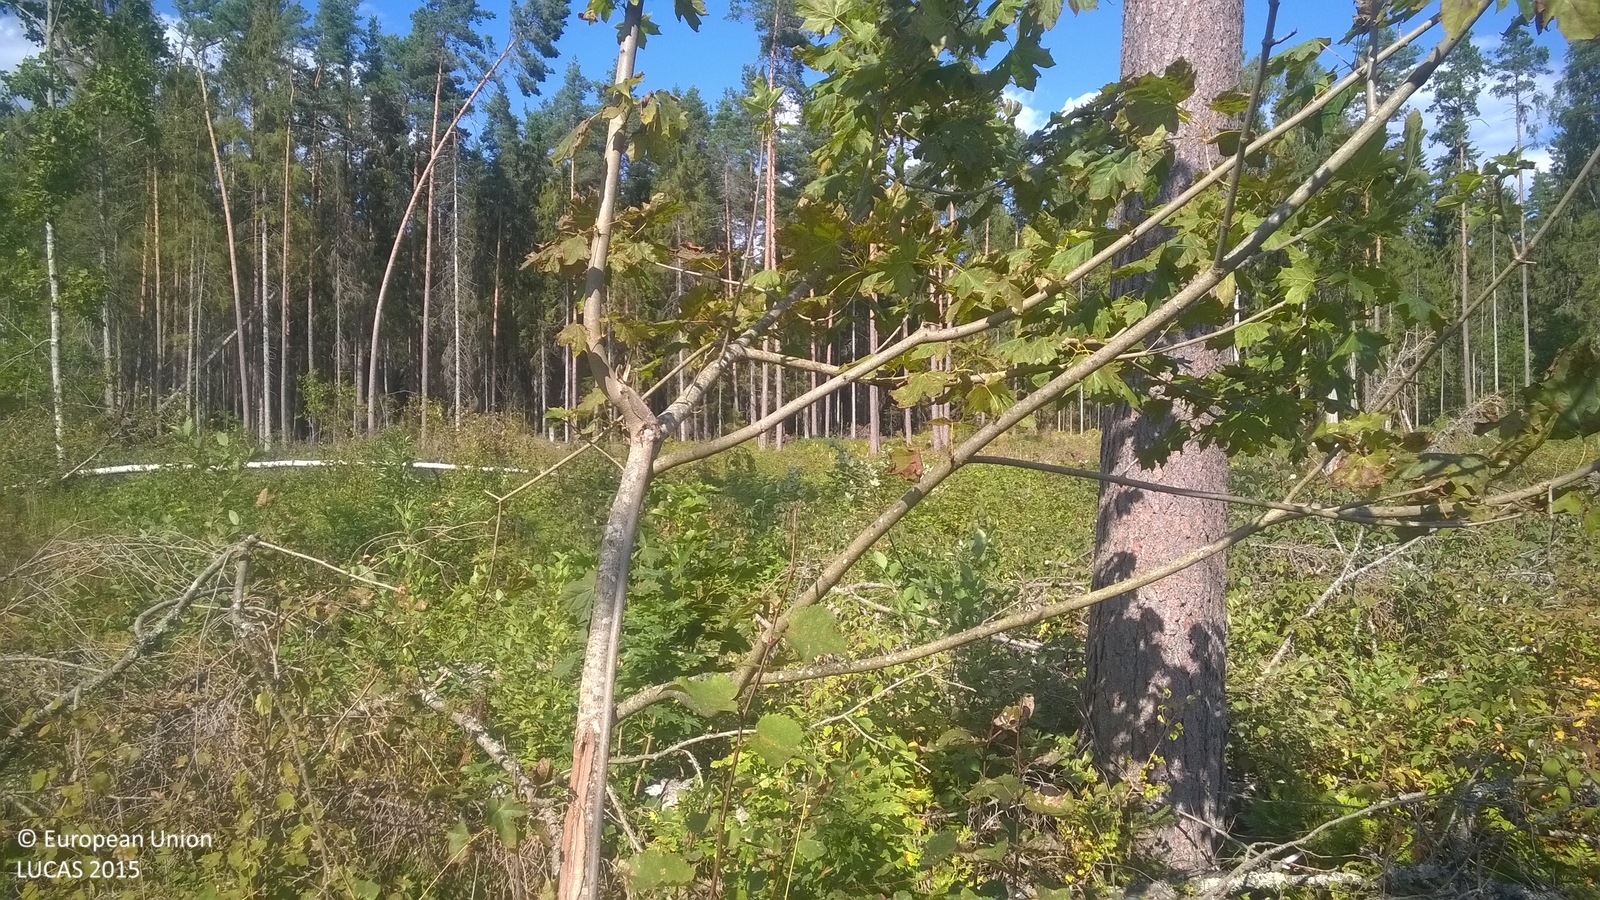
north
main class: Grassland
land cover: Grassland with sparse tree/shrub cover
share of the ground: > 75 %
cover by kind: herbaceous plants 85 %, shrubs 10 %, broadleaved forest trees 5 %
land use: Forestry
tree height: > 5 m
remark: Clear cut
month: August
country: LV
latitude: 57.8666
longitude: 25.7800
